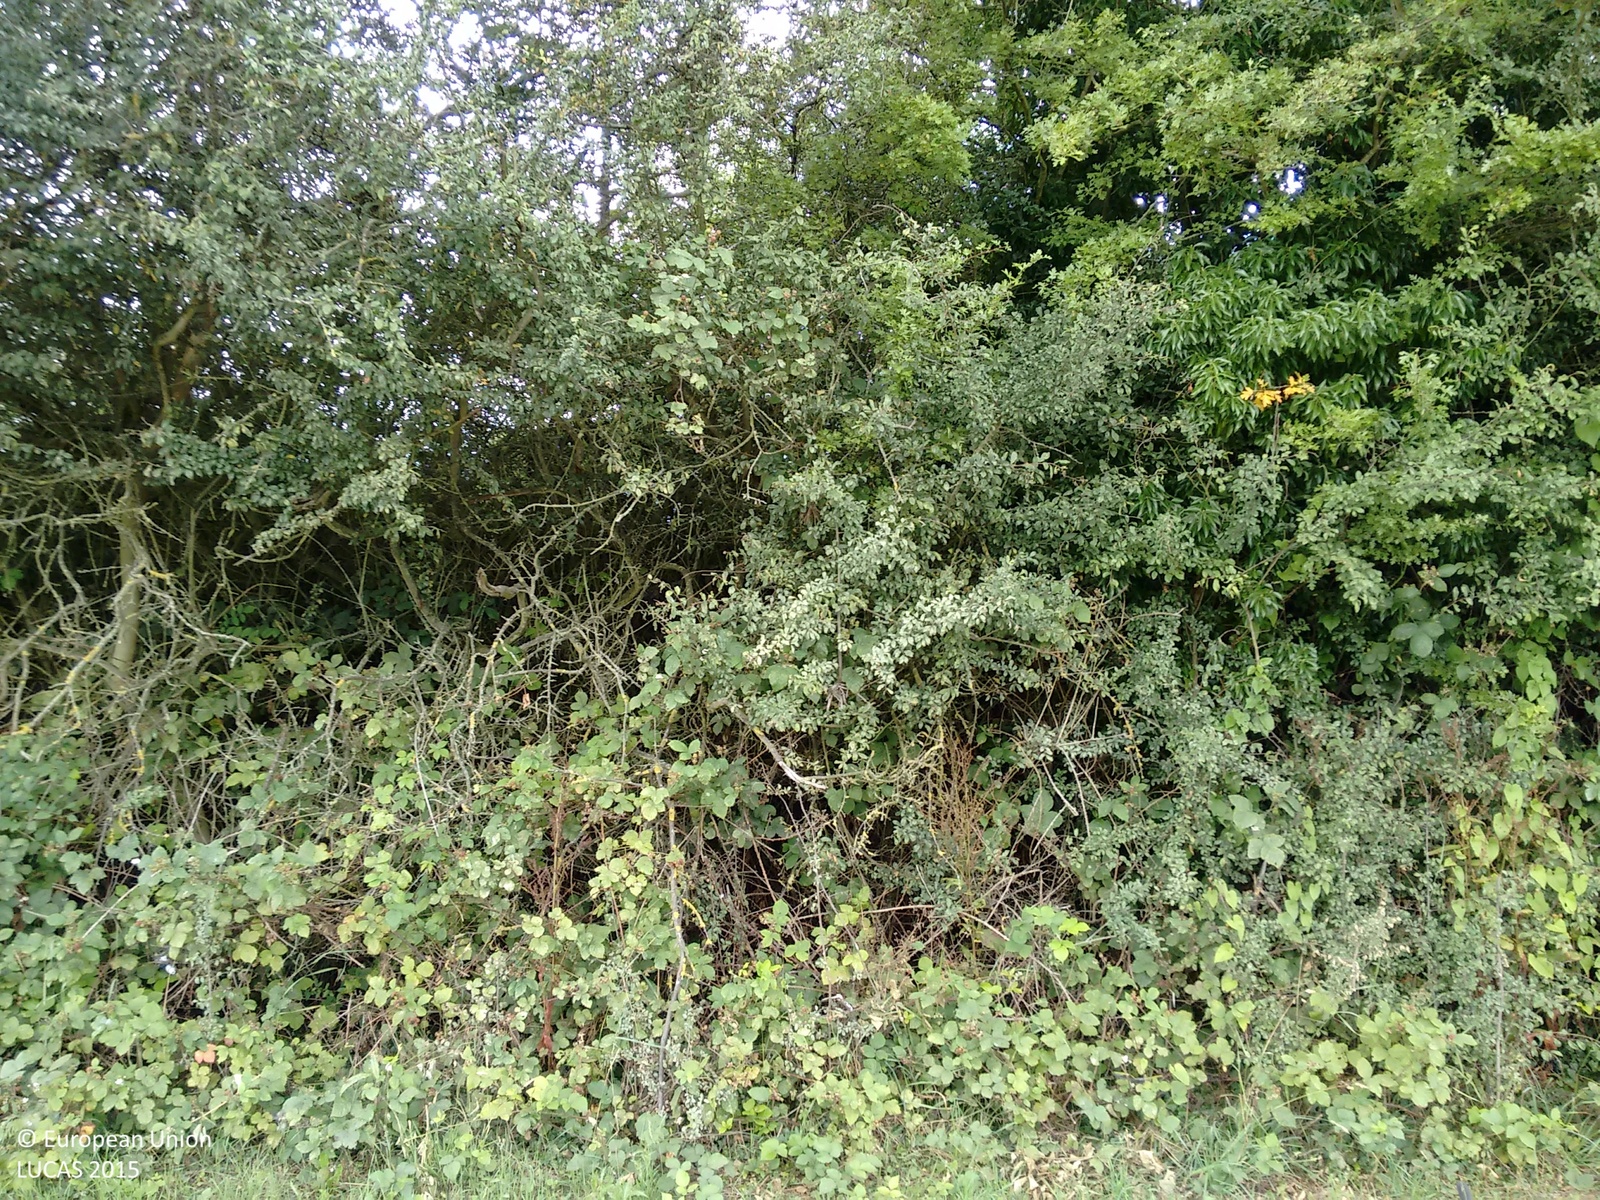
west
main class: Shrubland
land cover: Shrubland with sparse tree cover
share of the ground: > 75 %
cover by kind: shrubs 95 %, broadleaved forest trees 5 %
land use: Agriculture (excluding fallow land and kitchen gardens)
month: July
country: GB
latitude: 51.5510
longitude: -0.4648
